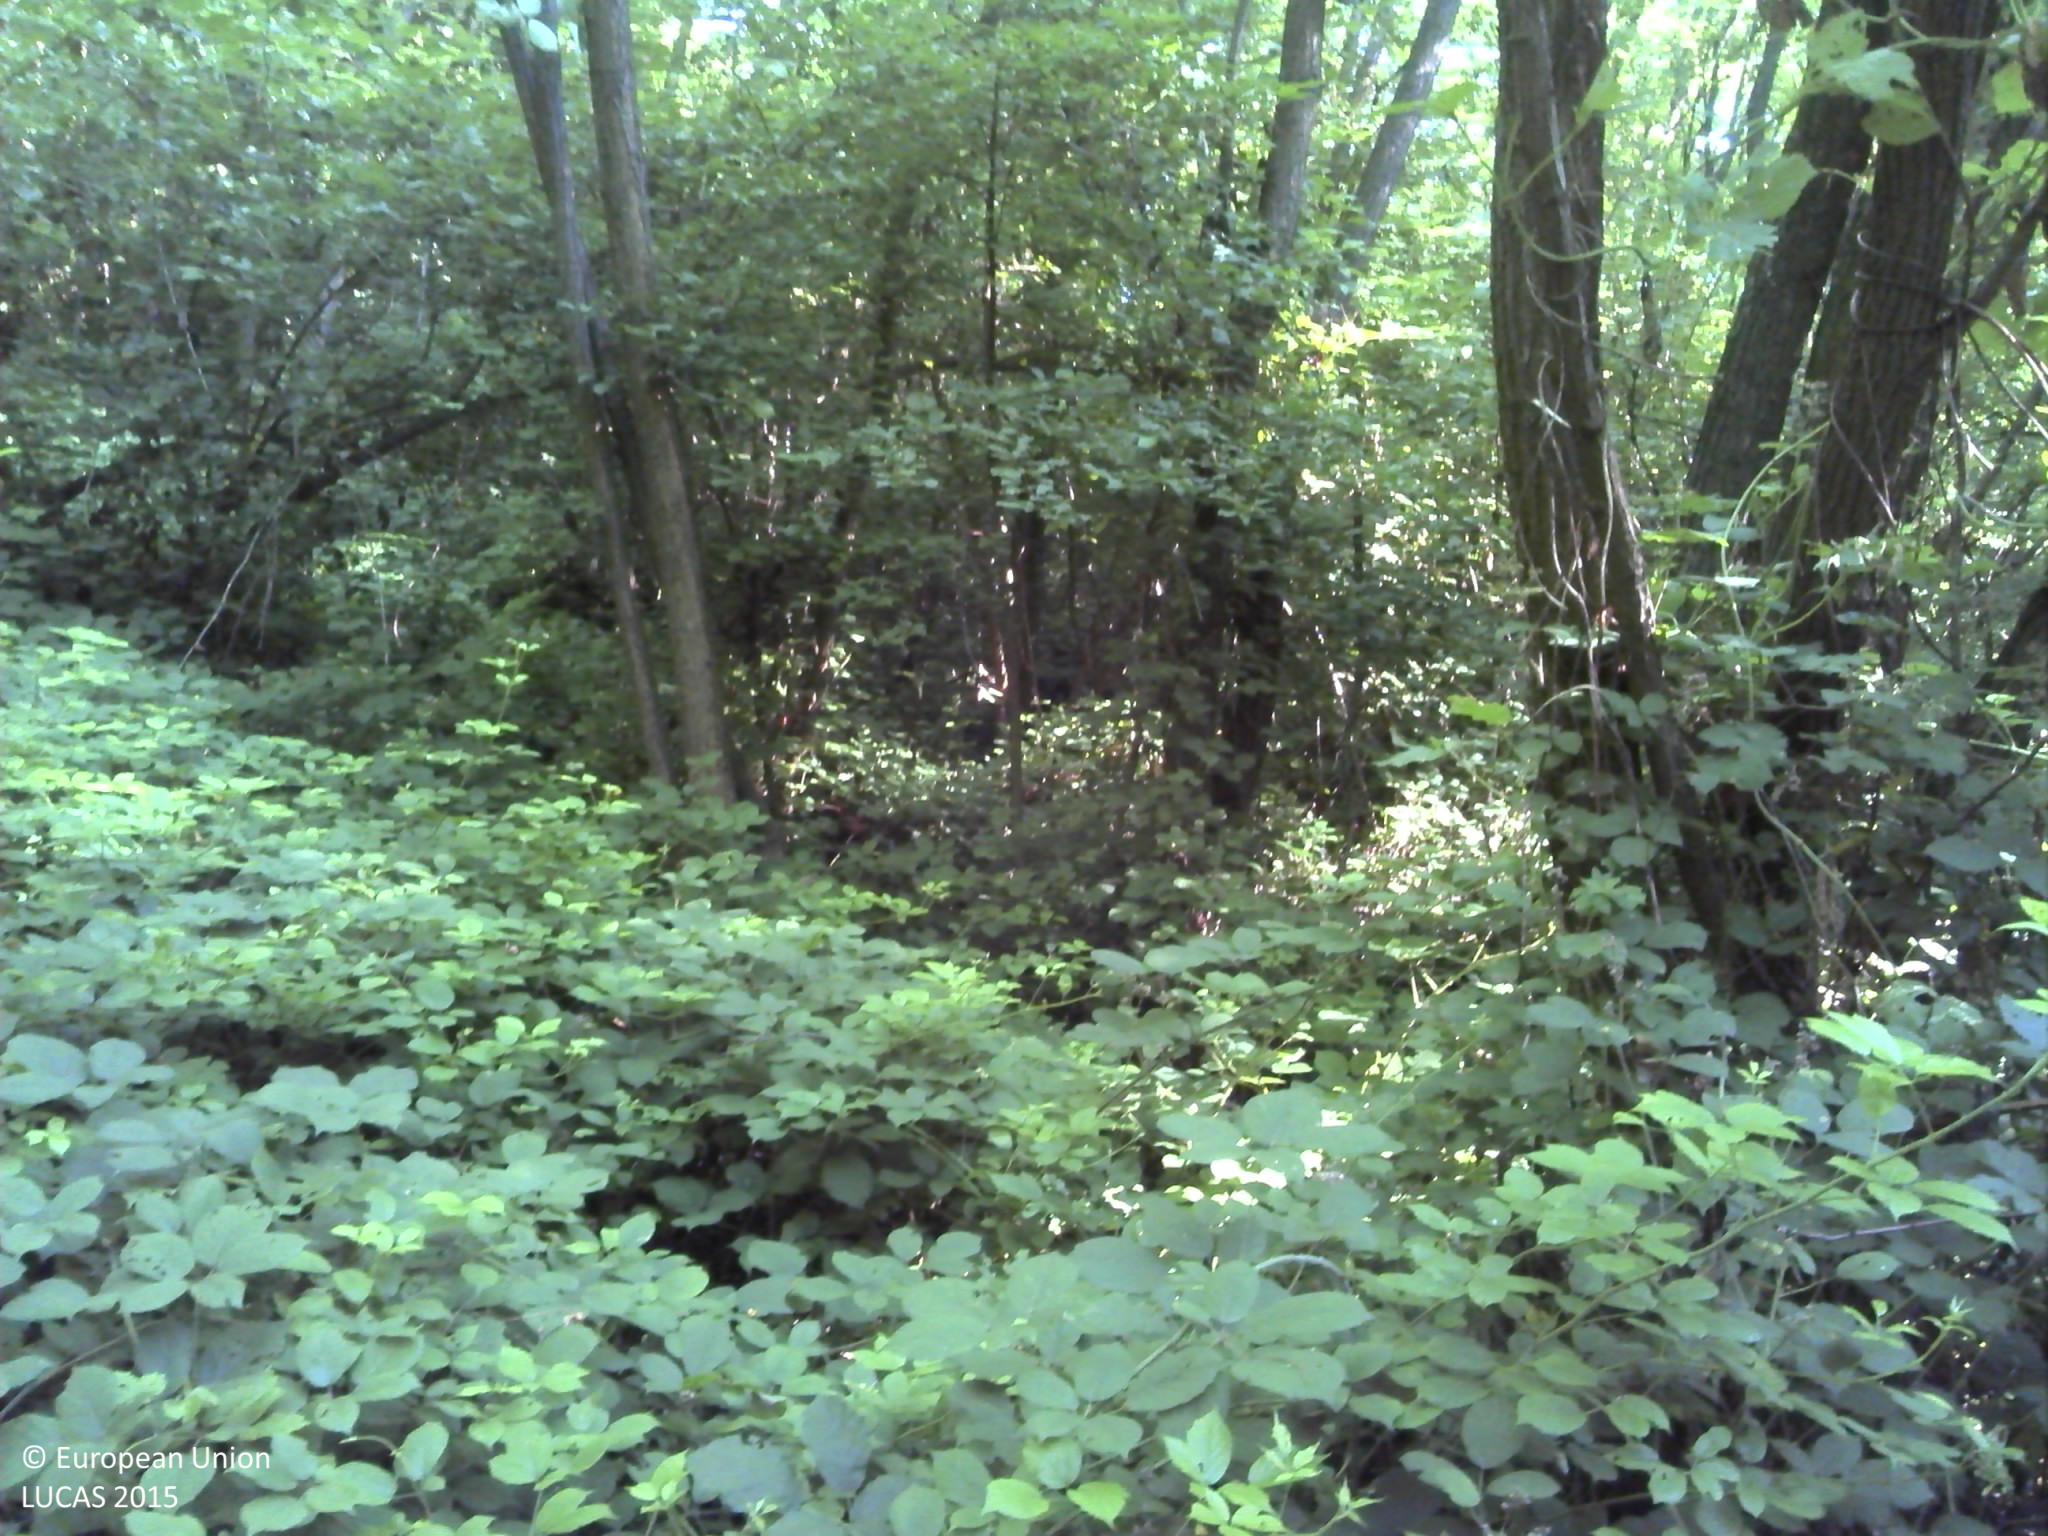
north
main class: Woodland
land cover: Broadleaved woodland
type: acidophilous oak and oak-birch forest
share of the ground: > 75 %
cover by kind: broadleaved forest trees 100 %
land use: Forestry
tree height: > 5 m
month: June
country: HR
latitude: 45.2802
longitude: 17.4070
